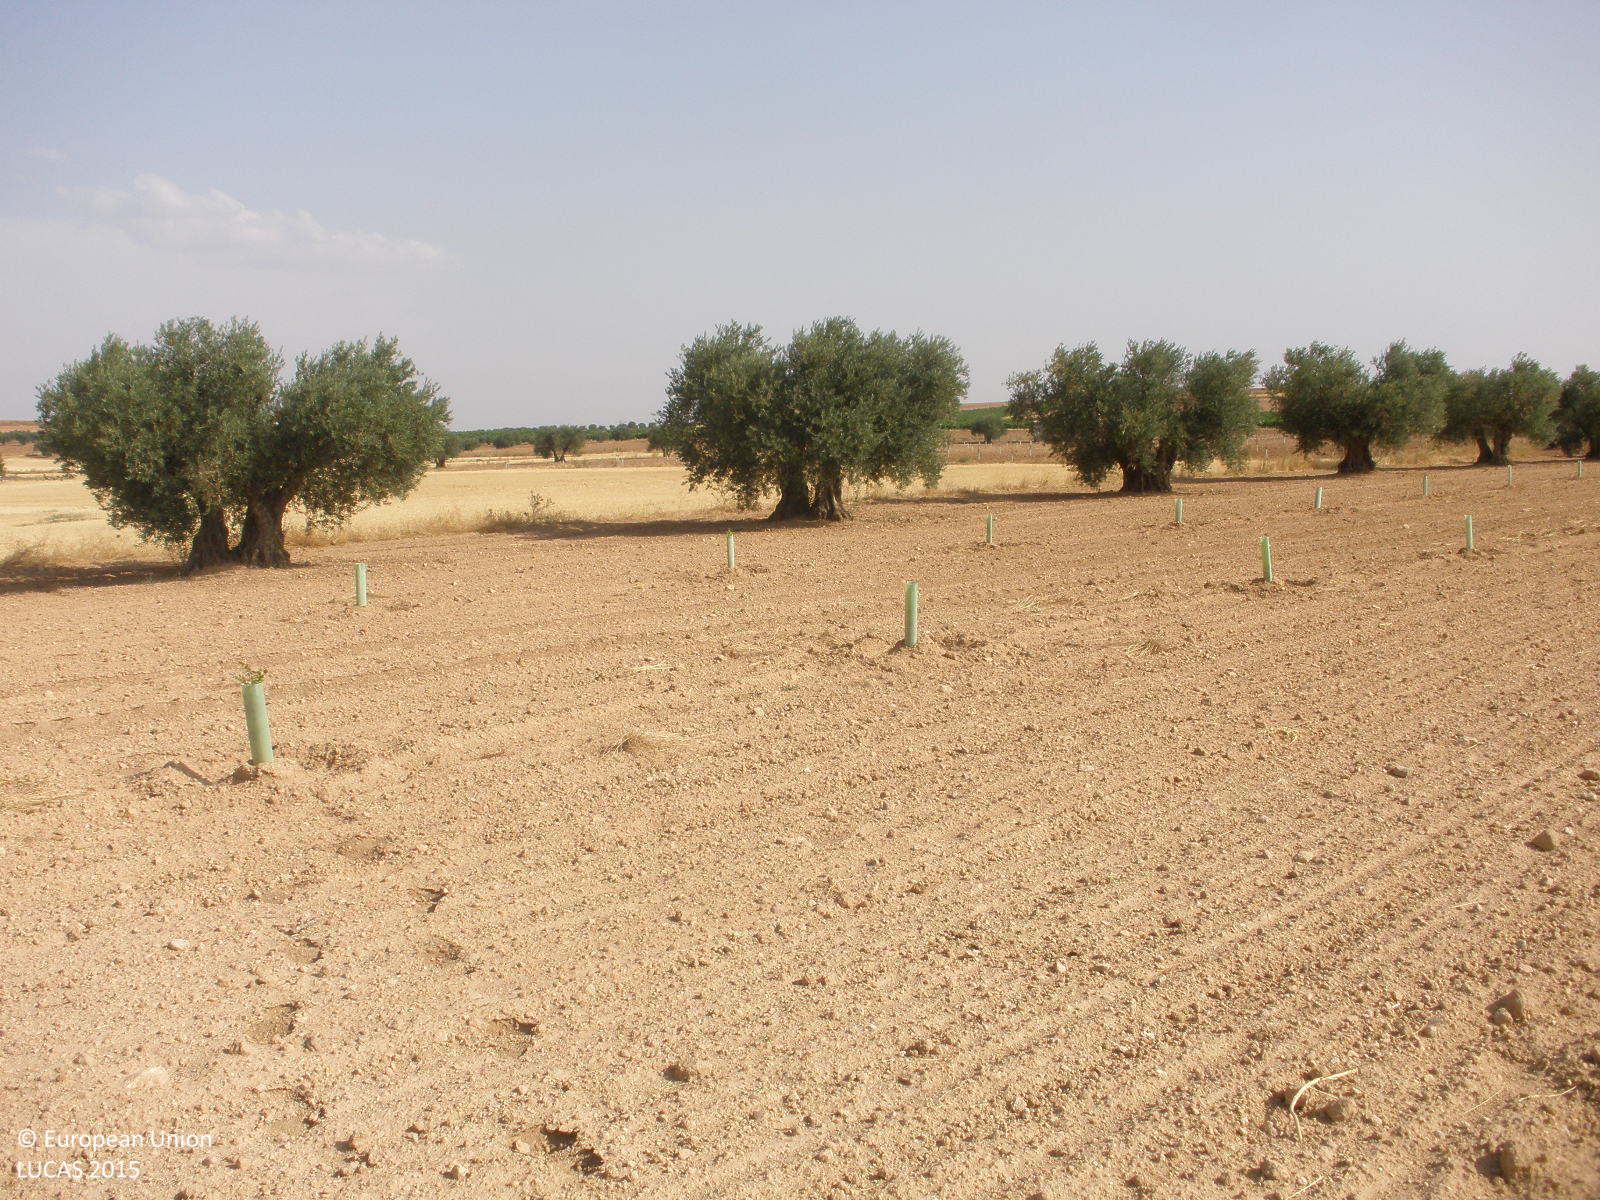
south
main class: Cropland
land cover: Nuts trees
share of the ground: < 10 %
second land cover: Other bare soil
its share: > 75 %
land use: Agriculture (excluding fallow land and kitchen gardens)
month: July
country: ES
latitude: 39.7074
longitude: -3.2846
